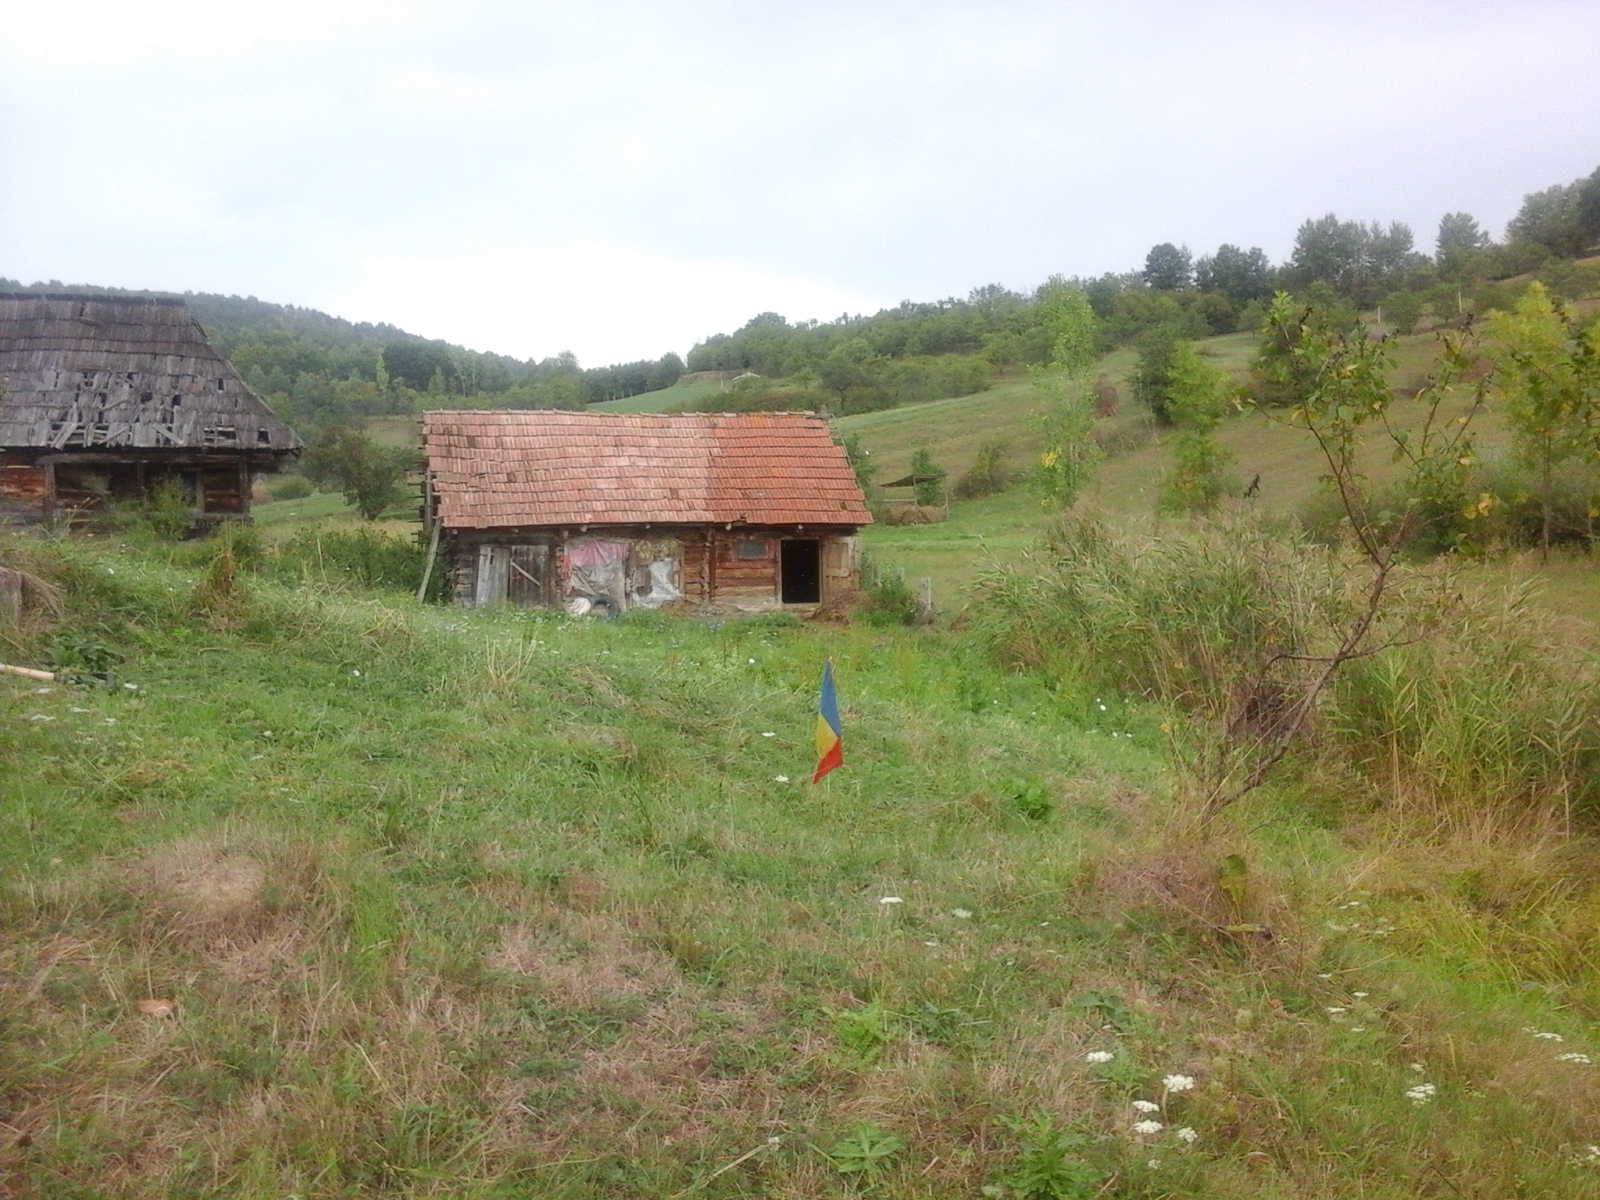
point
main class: Grassland
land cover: Grassland with sparse tree/shrub cover
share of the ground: < 10 %
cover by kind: herbaceous plants 95 %, broadleaved forest trees 5 %
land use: Agriculture (excluding fallow land and kitchen gardens)
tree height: > 5 m
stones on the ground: < 10 %
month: September
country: RO
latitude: 47.7526
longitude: 24.0791
